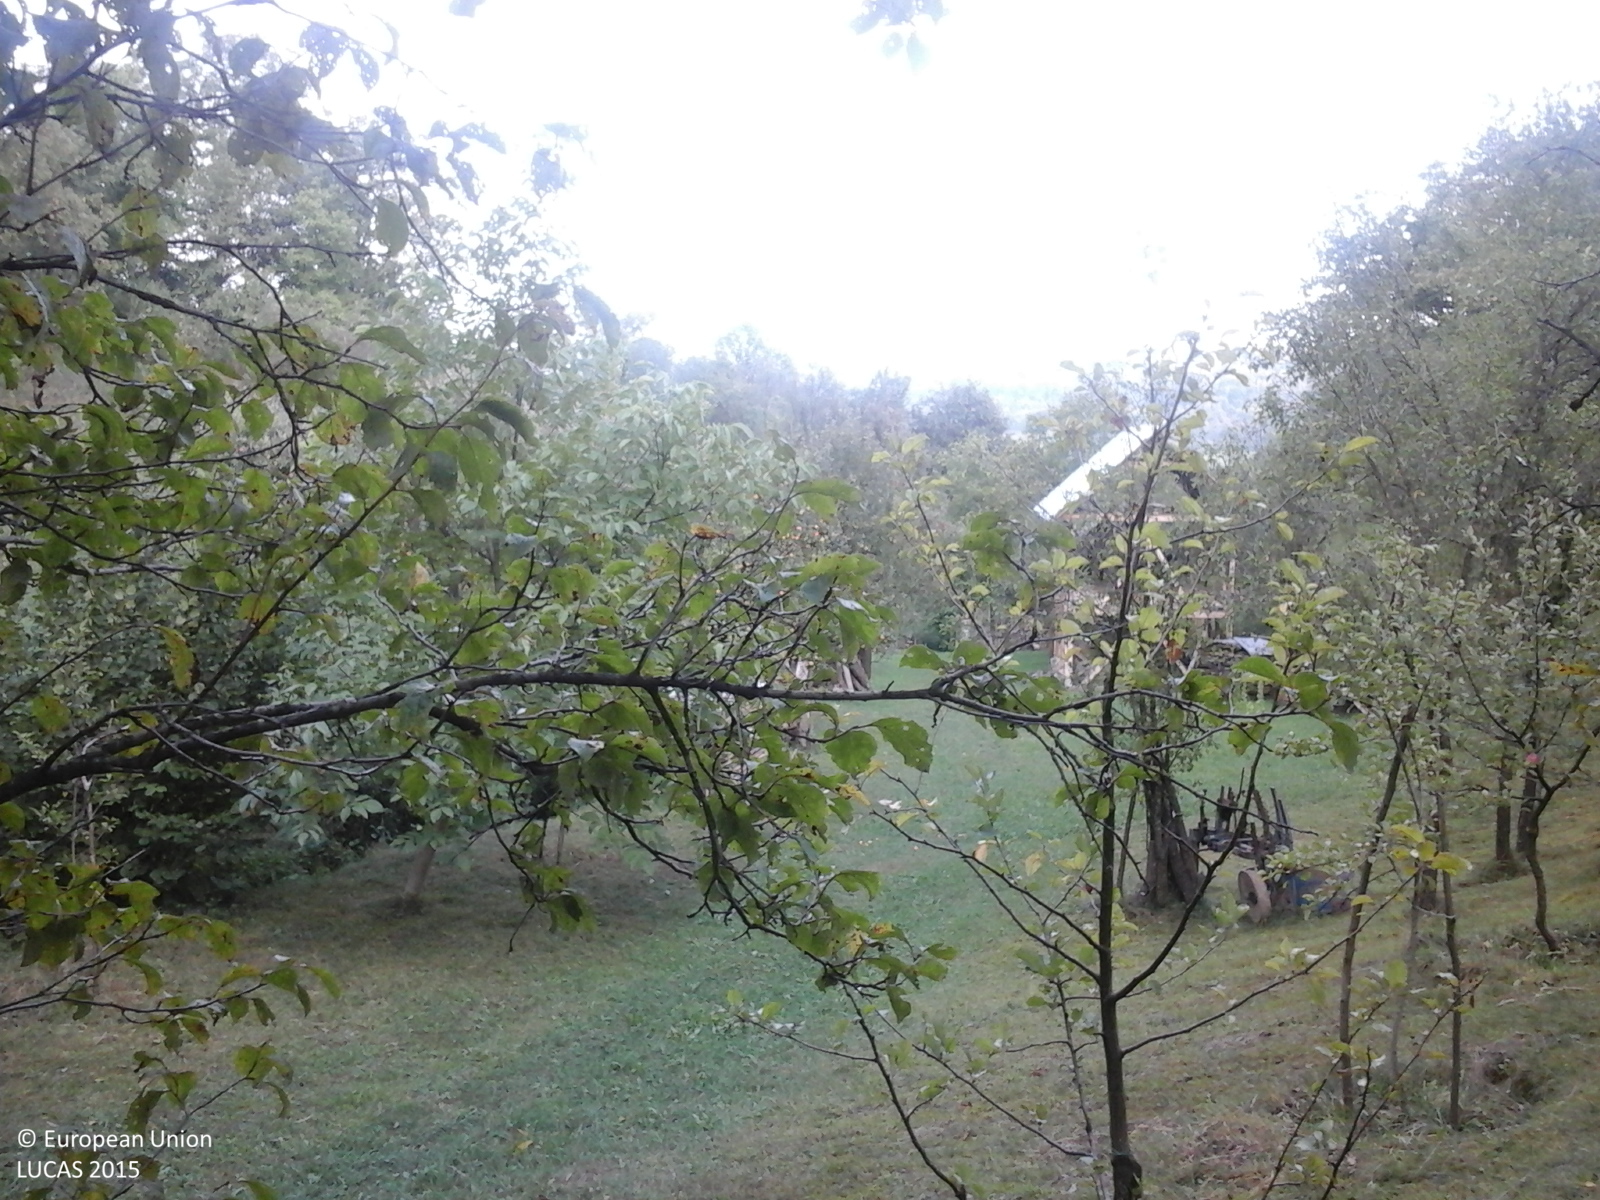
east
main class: Cropland
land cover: Other fruit trees and berries
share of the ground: 50 - 75 %
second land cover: Grassland without tree/shrub cover
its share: > 75 %
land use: Agriculture (excluding fallow land and kitchen gardens)
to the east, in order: Other fruit trees and berries; Grassland without tree/shrub cover; Grassland with sparse tree/shrub cover; Arable land (only in case pi); Artificial constructions in urban areas; Other fruit trees and berries; Electric lines; Other fruit trees and berries; Fences; Grass margins; Artificial constructions; Paved roads, cycling and walking lanes; Grass margins; Electric lines; Fences; Other fruit trees and berries; Fences; Abandoned hedges; Grassland without tree/shrub cover; Fences; Abandoned hedges; Lucerne
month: September
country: RO
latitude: 47.7940
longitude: 23.9000
